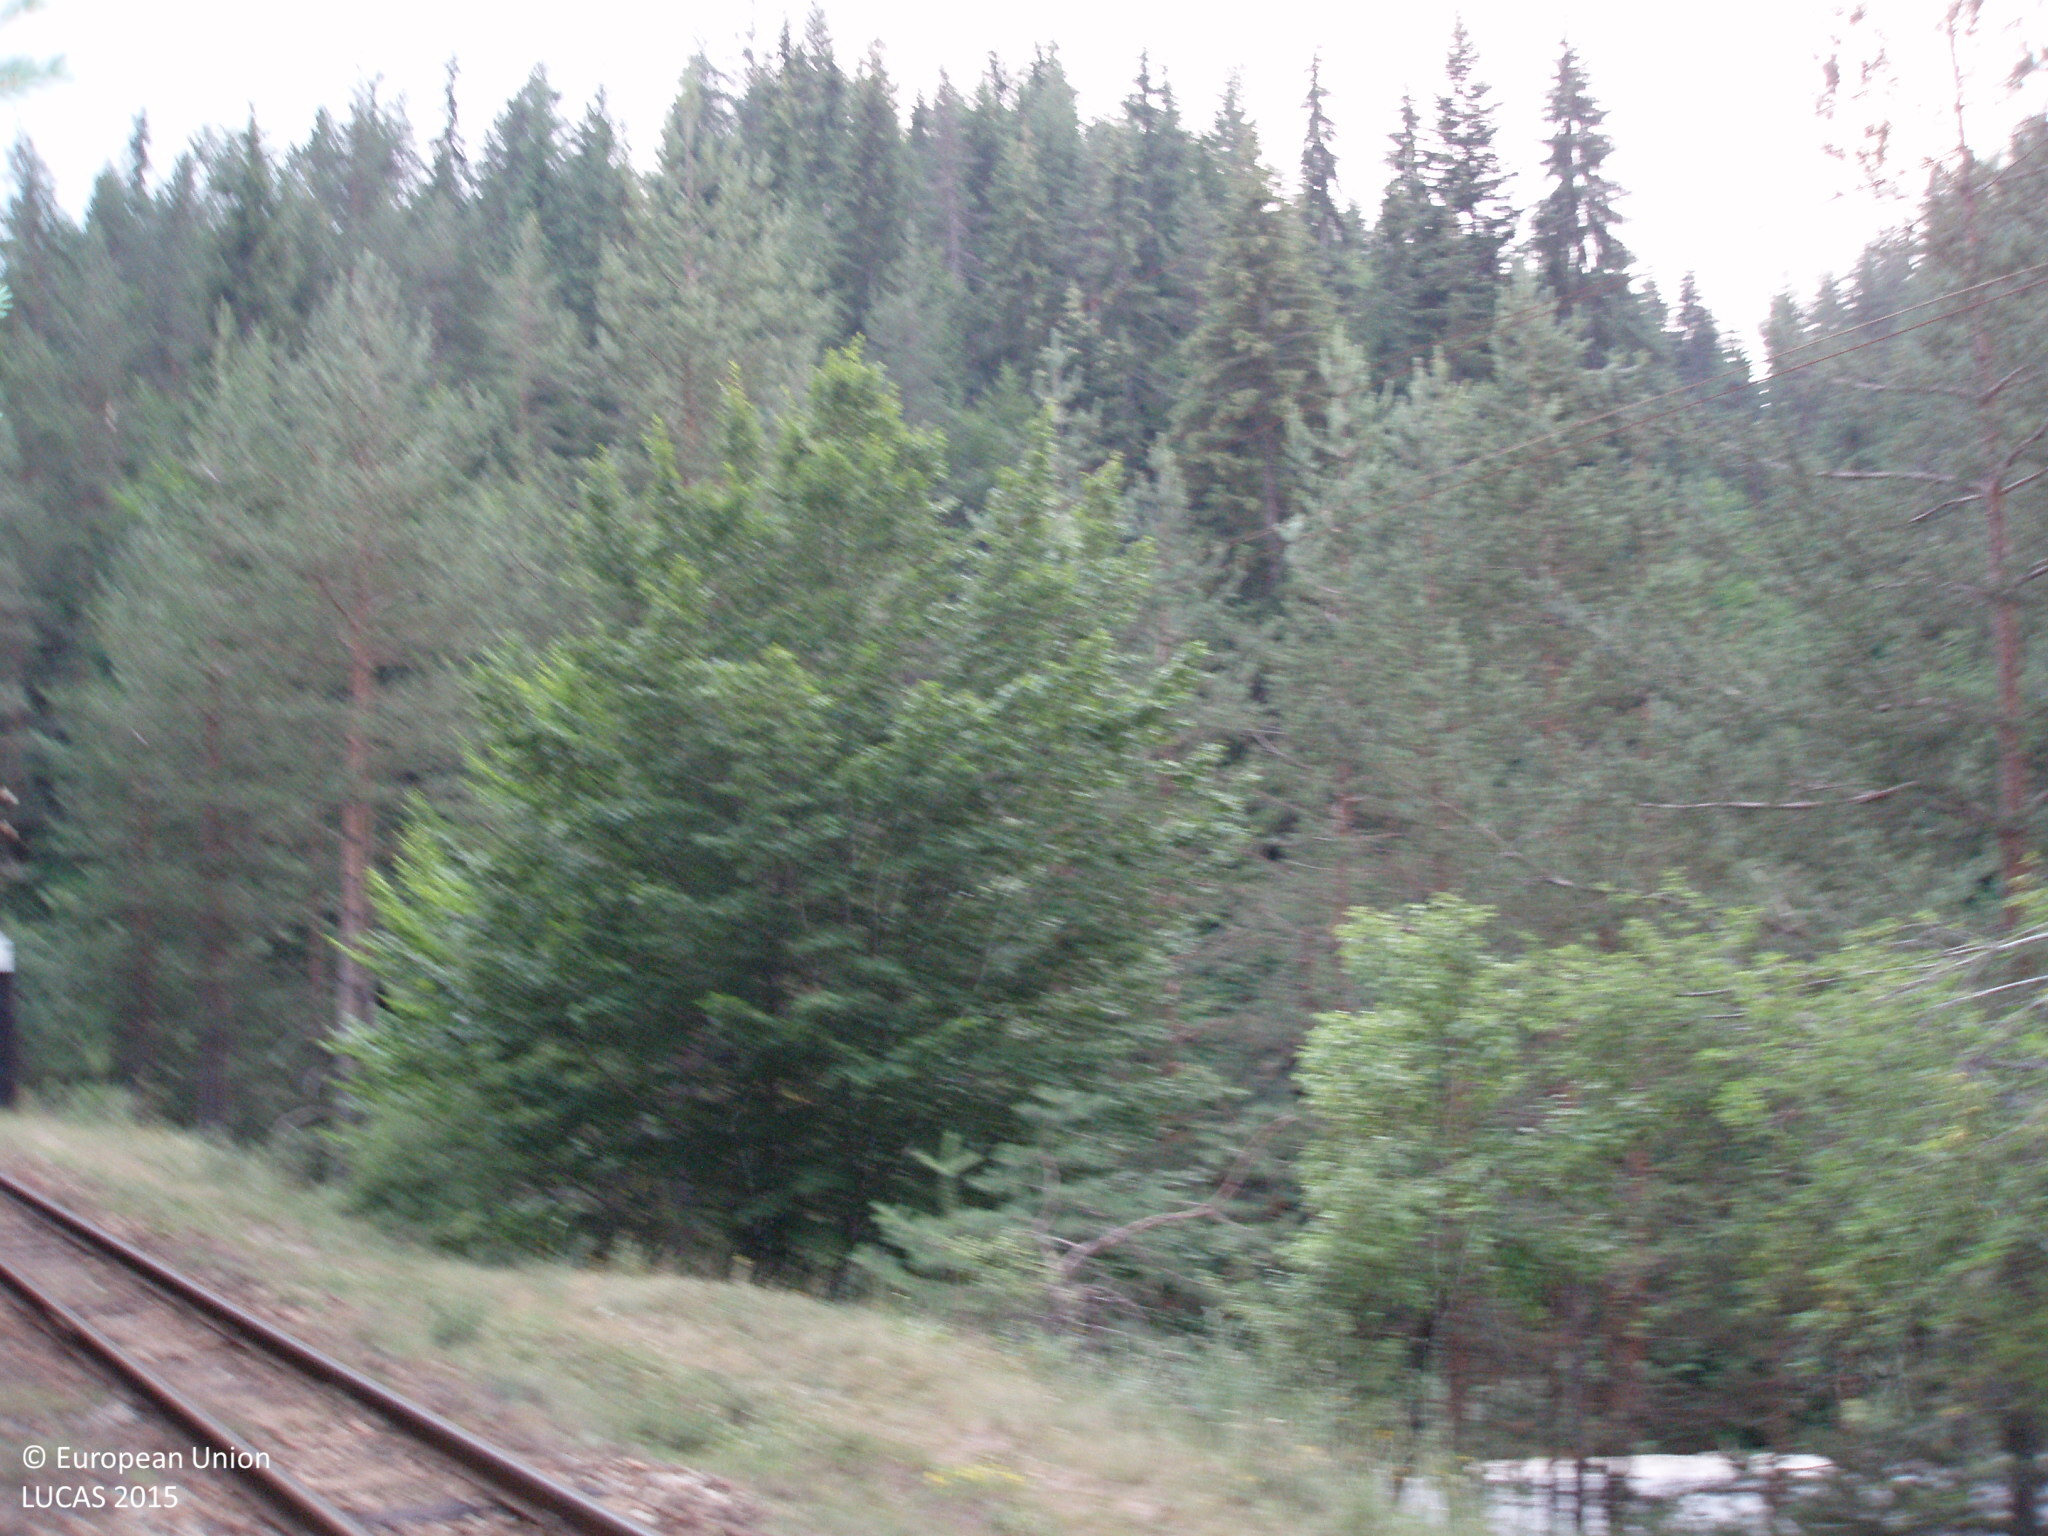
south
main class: Woodland
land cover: Other mixed woodland
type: hemiboreal forest and nemoral coniferous forest and mixed broadleaved-coniferous forest
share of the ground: 50 - 75 %
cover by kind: coniferous forest trees 65 %, broadleaved forest trees 25 %, herbaceous plants 10 %
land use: Forestry
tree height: > 5 m
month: July
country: BG
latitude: 42.0412
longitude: 23.7452
